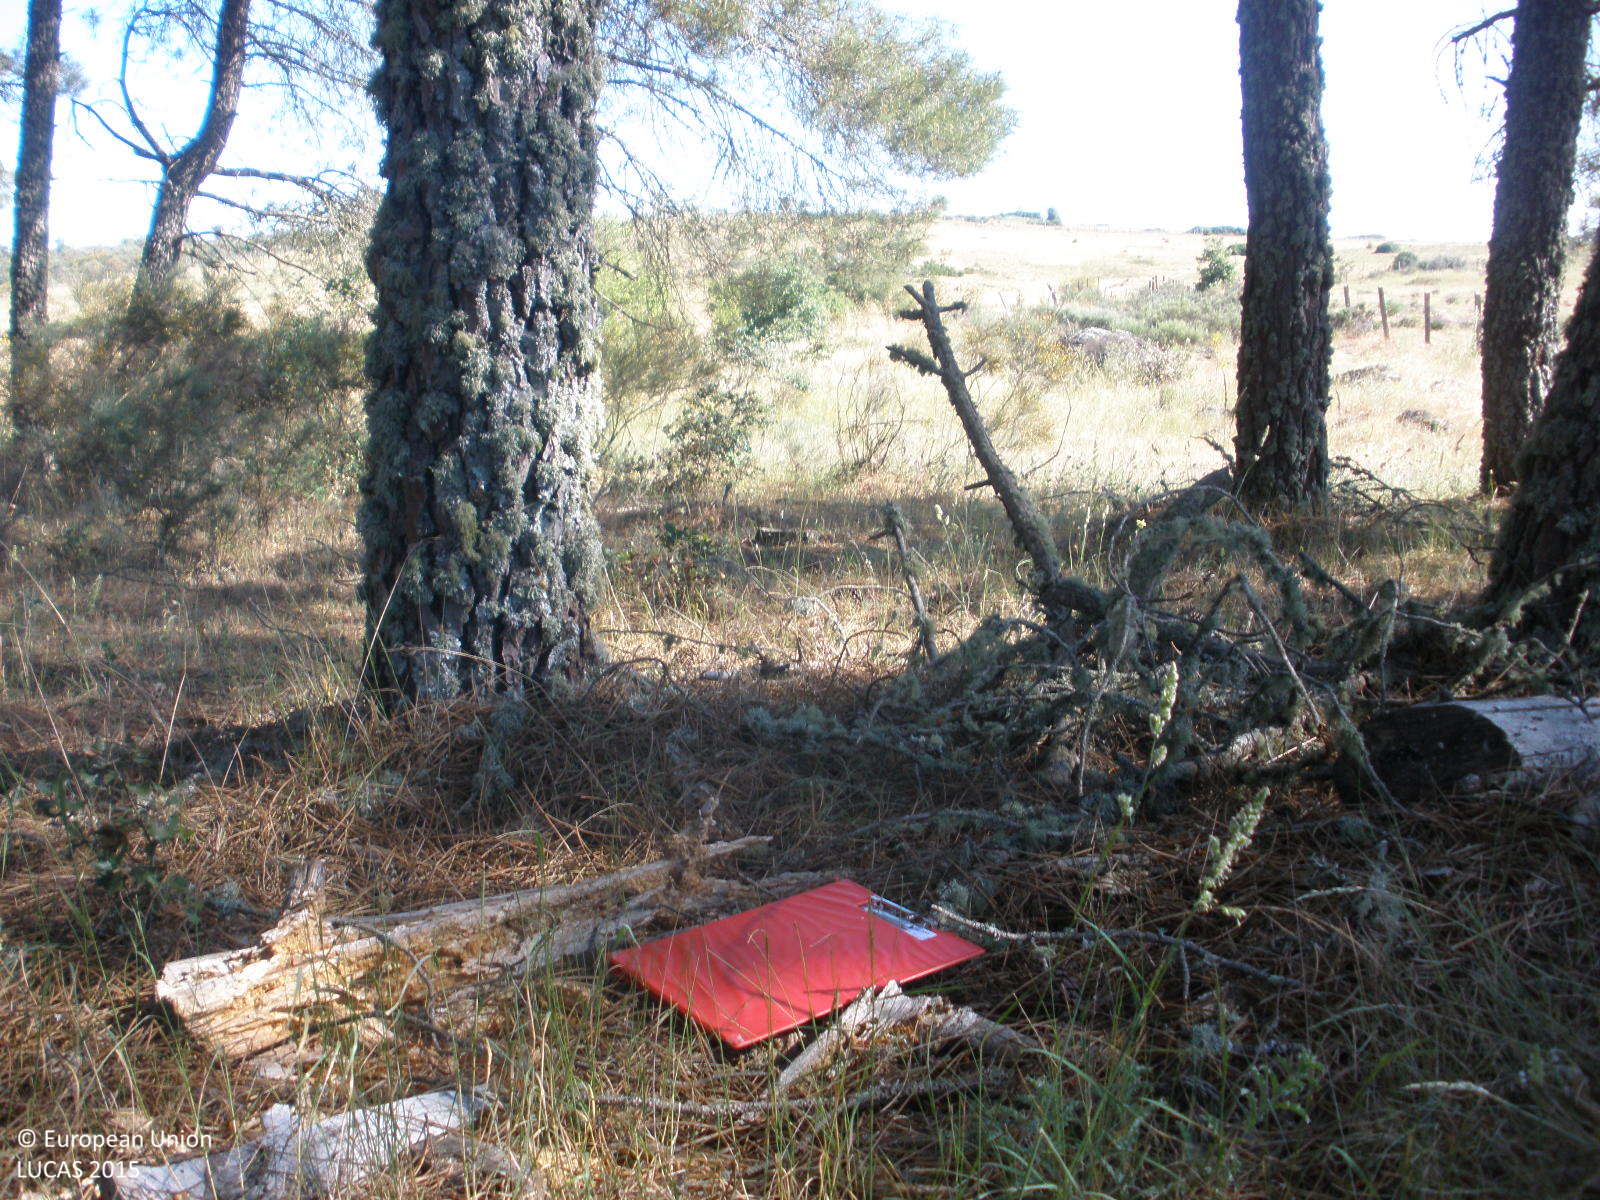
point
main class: Woodland
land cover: Pine dominated coniferous woodland
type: coniferous forest of the mediterranean region
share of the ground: > 75 %
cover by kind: coniferous forest trees 80 %, shrubs 10 %, herbaceous plants 10 %
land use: Forestry
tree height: > 5 m
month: June
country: ES
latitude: 40.4101
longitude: -6.6941
